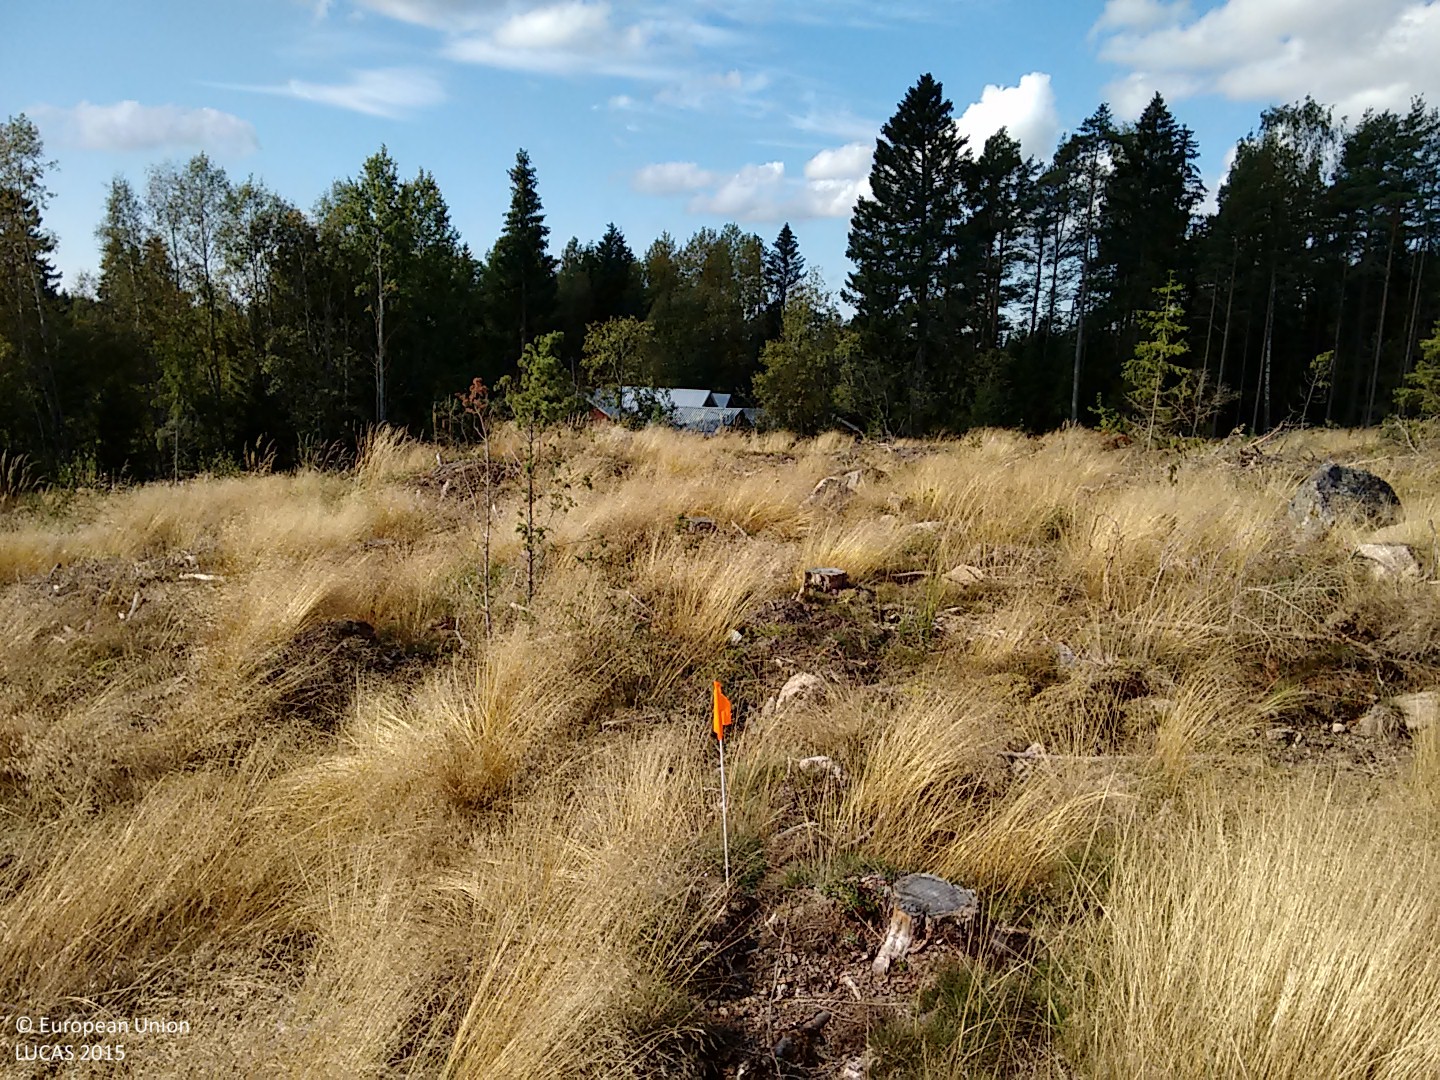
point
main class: Grassland
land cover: Grassland with sparse tree/shrub cover
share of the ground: > 75 %
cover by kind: herbaceous plants 80 %, consolidated bare surface 10 %, broadleaved forest trees 5 %, unconsolidated bare surface 5 %
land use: Forestry
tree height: < 5 m
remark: Clear cut
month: September
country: FI
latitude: 60.9348
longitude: 21.6630
